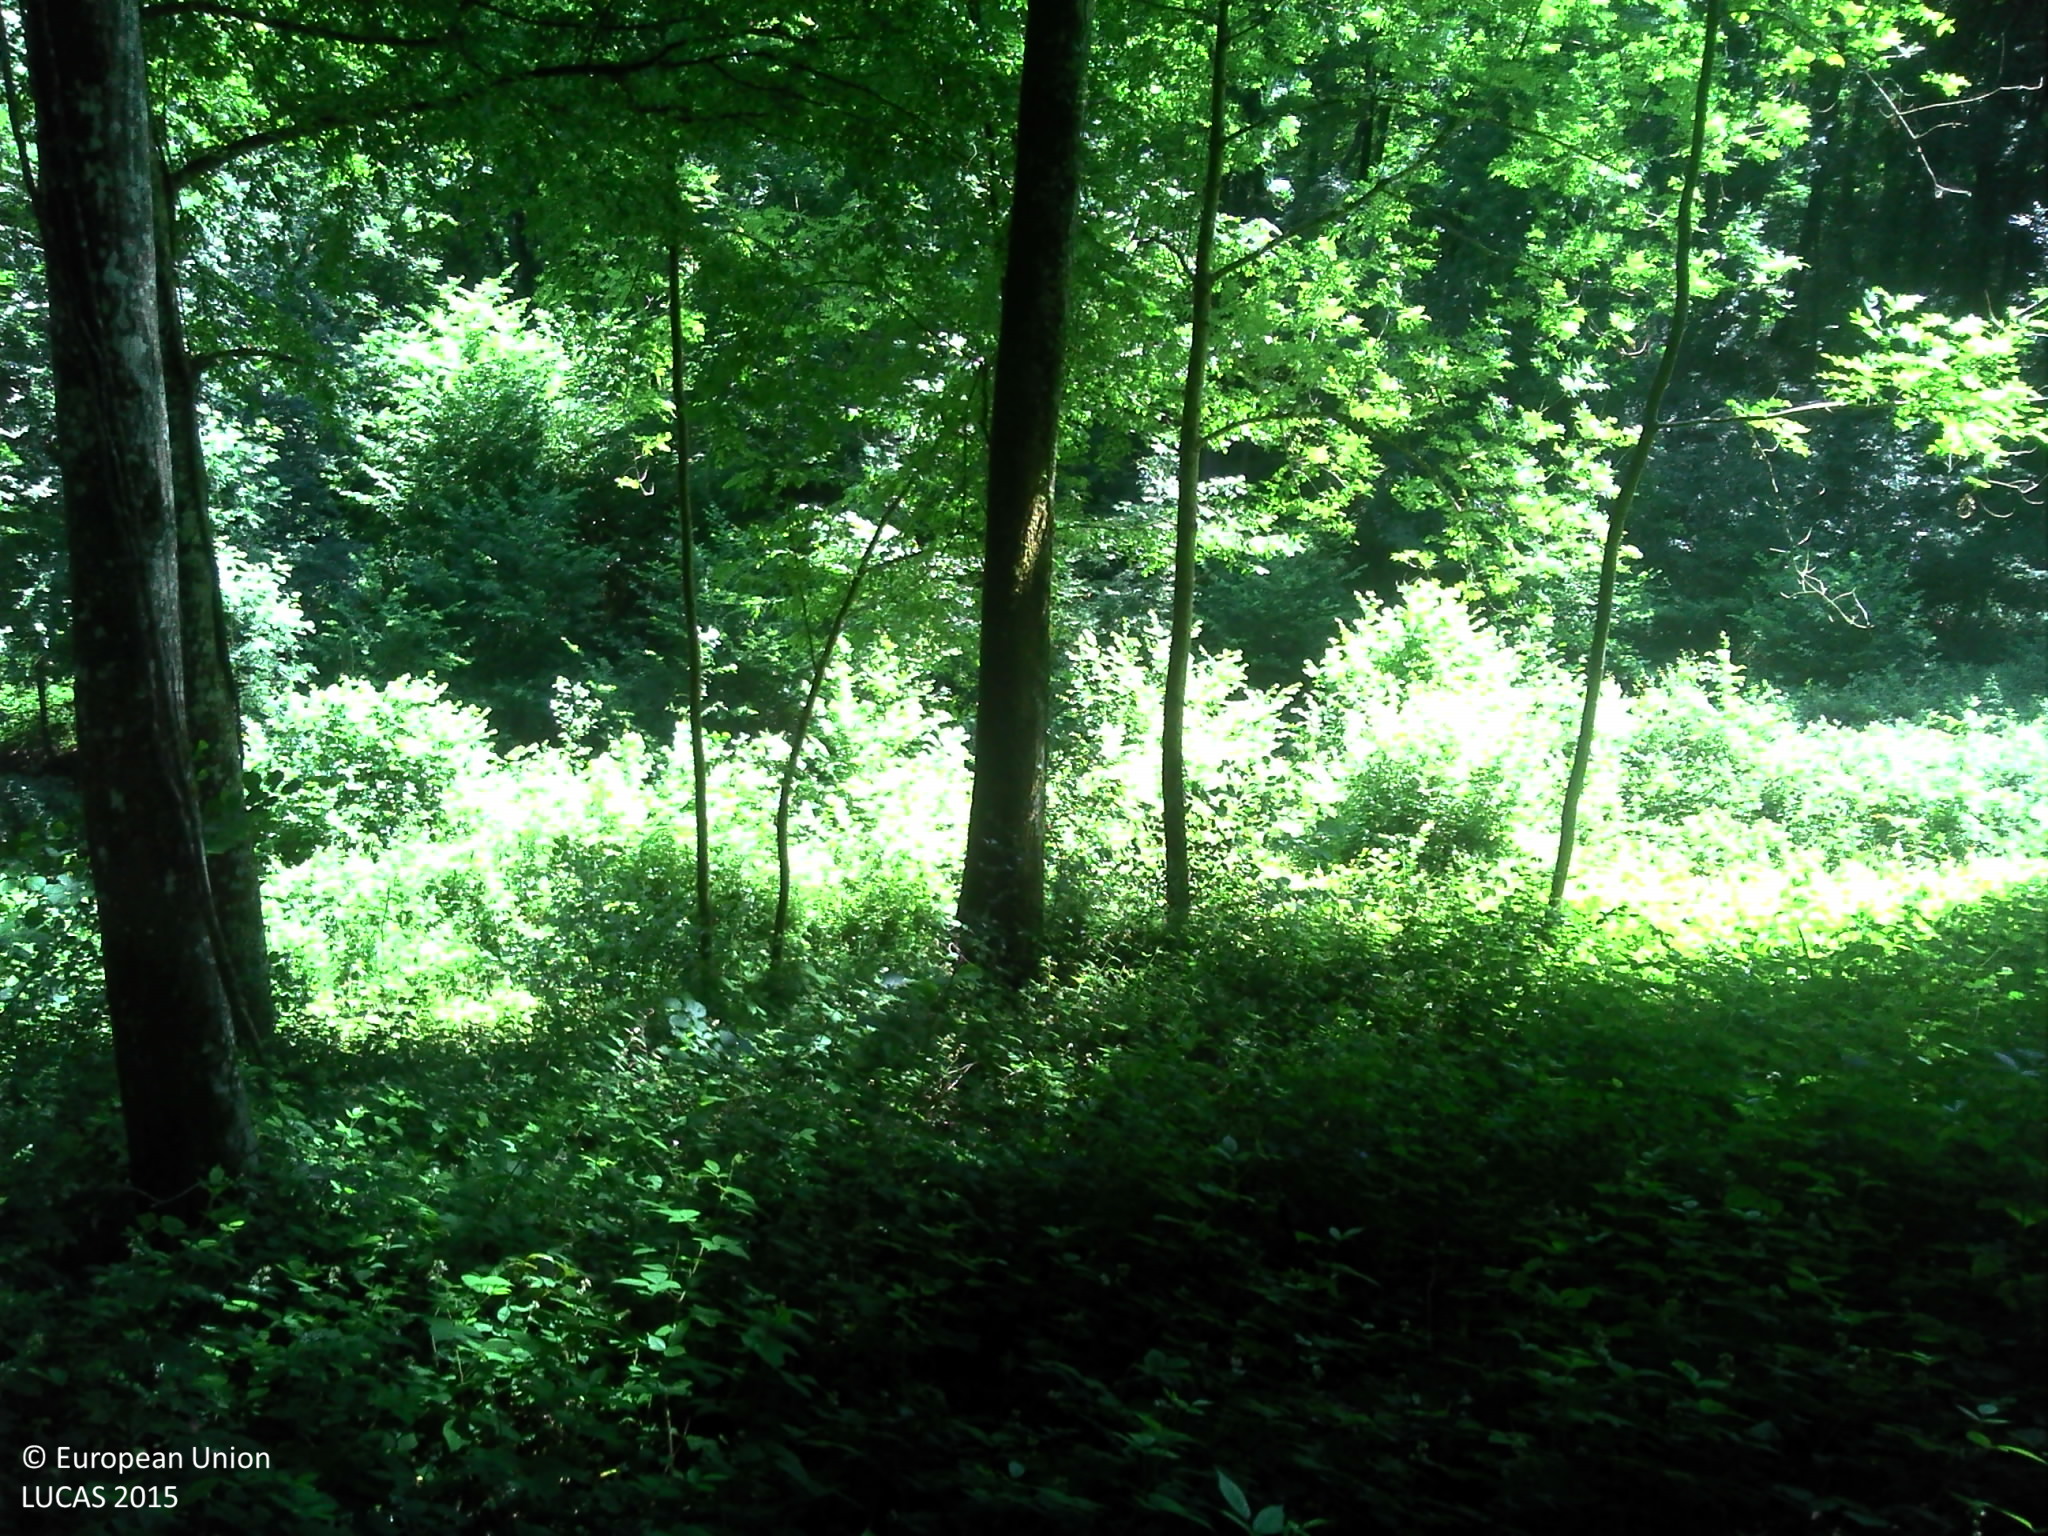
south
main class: Woodland
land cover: Broadleaved woodland
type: mesophytic deciduous forest
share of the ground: > 75 %
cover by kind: broadleaved forest trees 80 %, herbaceous plants 10 %, consolidated bare surface 10 %
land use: Forestry
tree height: > 5 m
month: June
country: FR
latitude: 49.1287
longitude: 1.0848
